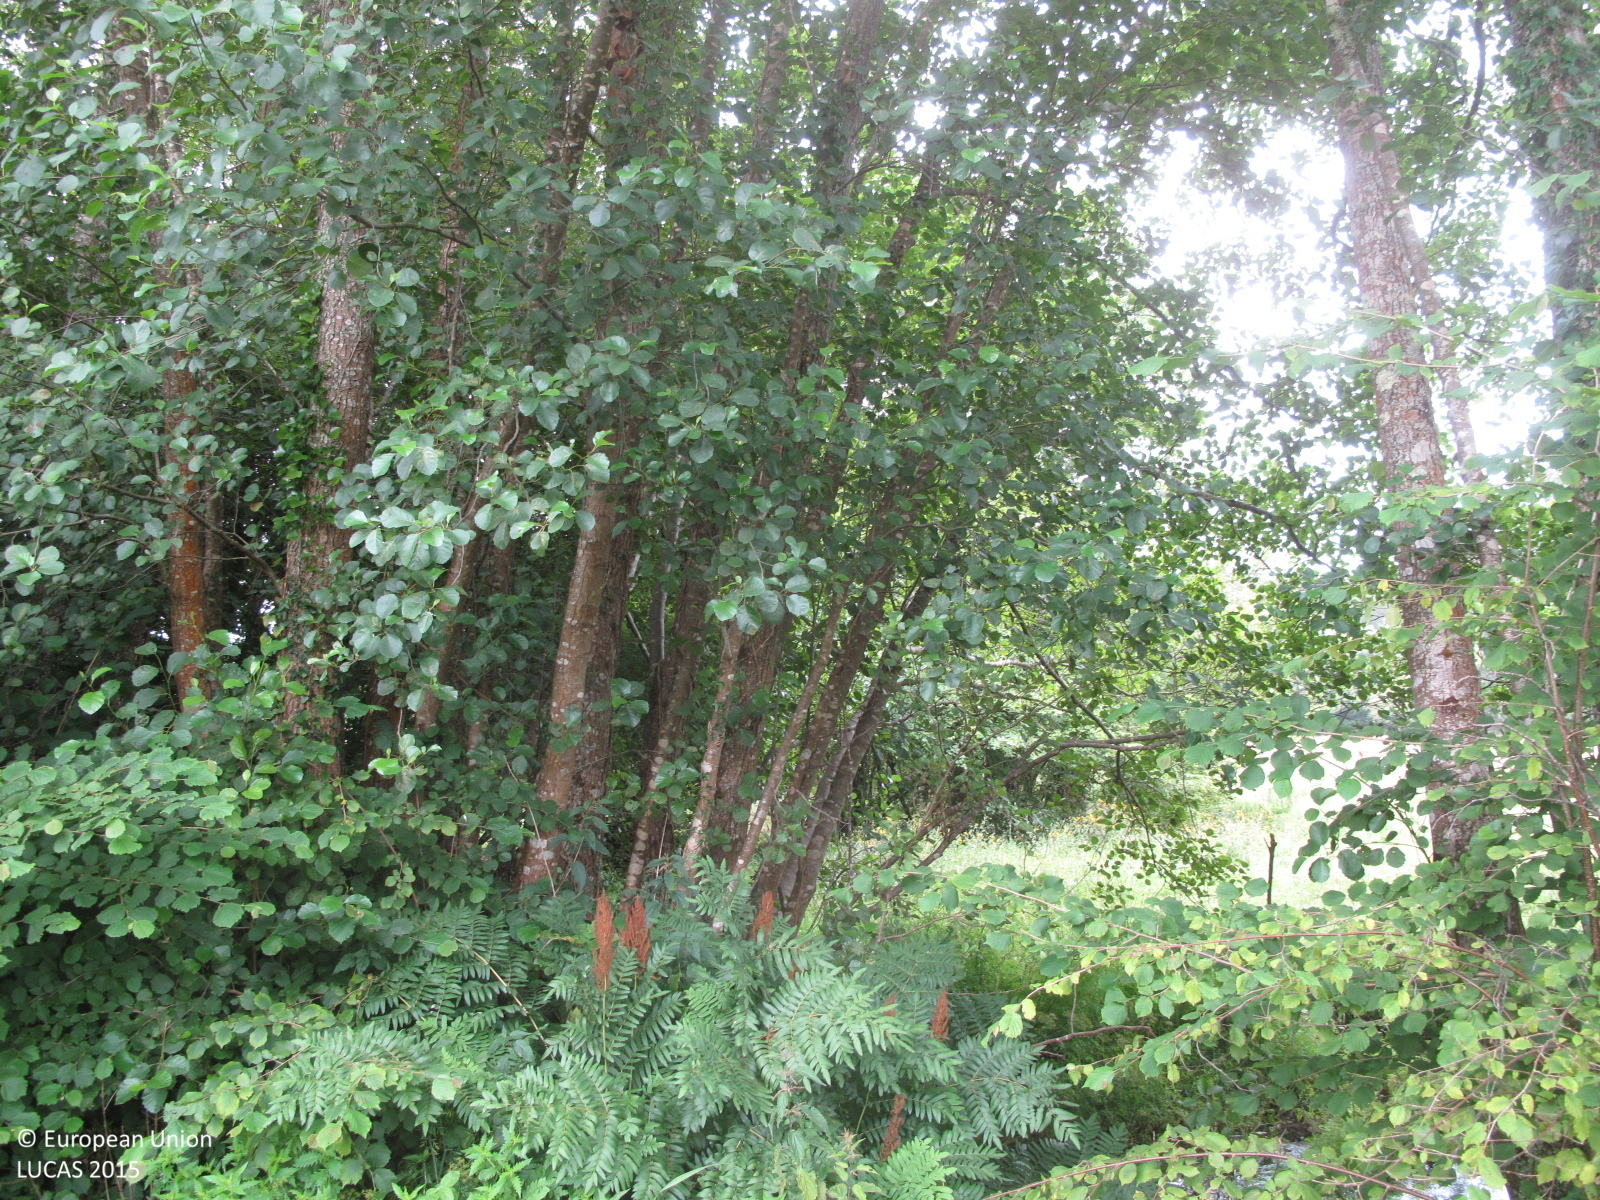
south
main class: Grassland
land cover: Grassland without tree/shrub cover
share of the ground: > 75 %
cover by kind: herbaceous plants 100 %
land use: Agriculture (excluding fallow land and kitchen gardens)
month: July
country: ES
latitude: 43.5828
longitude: -8.0434
